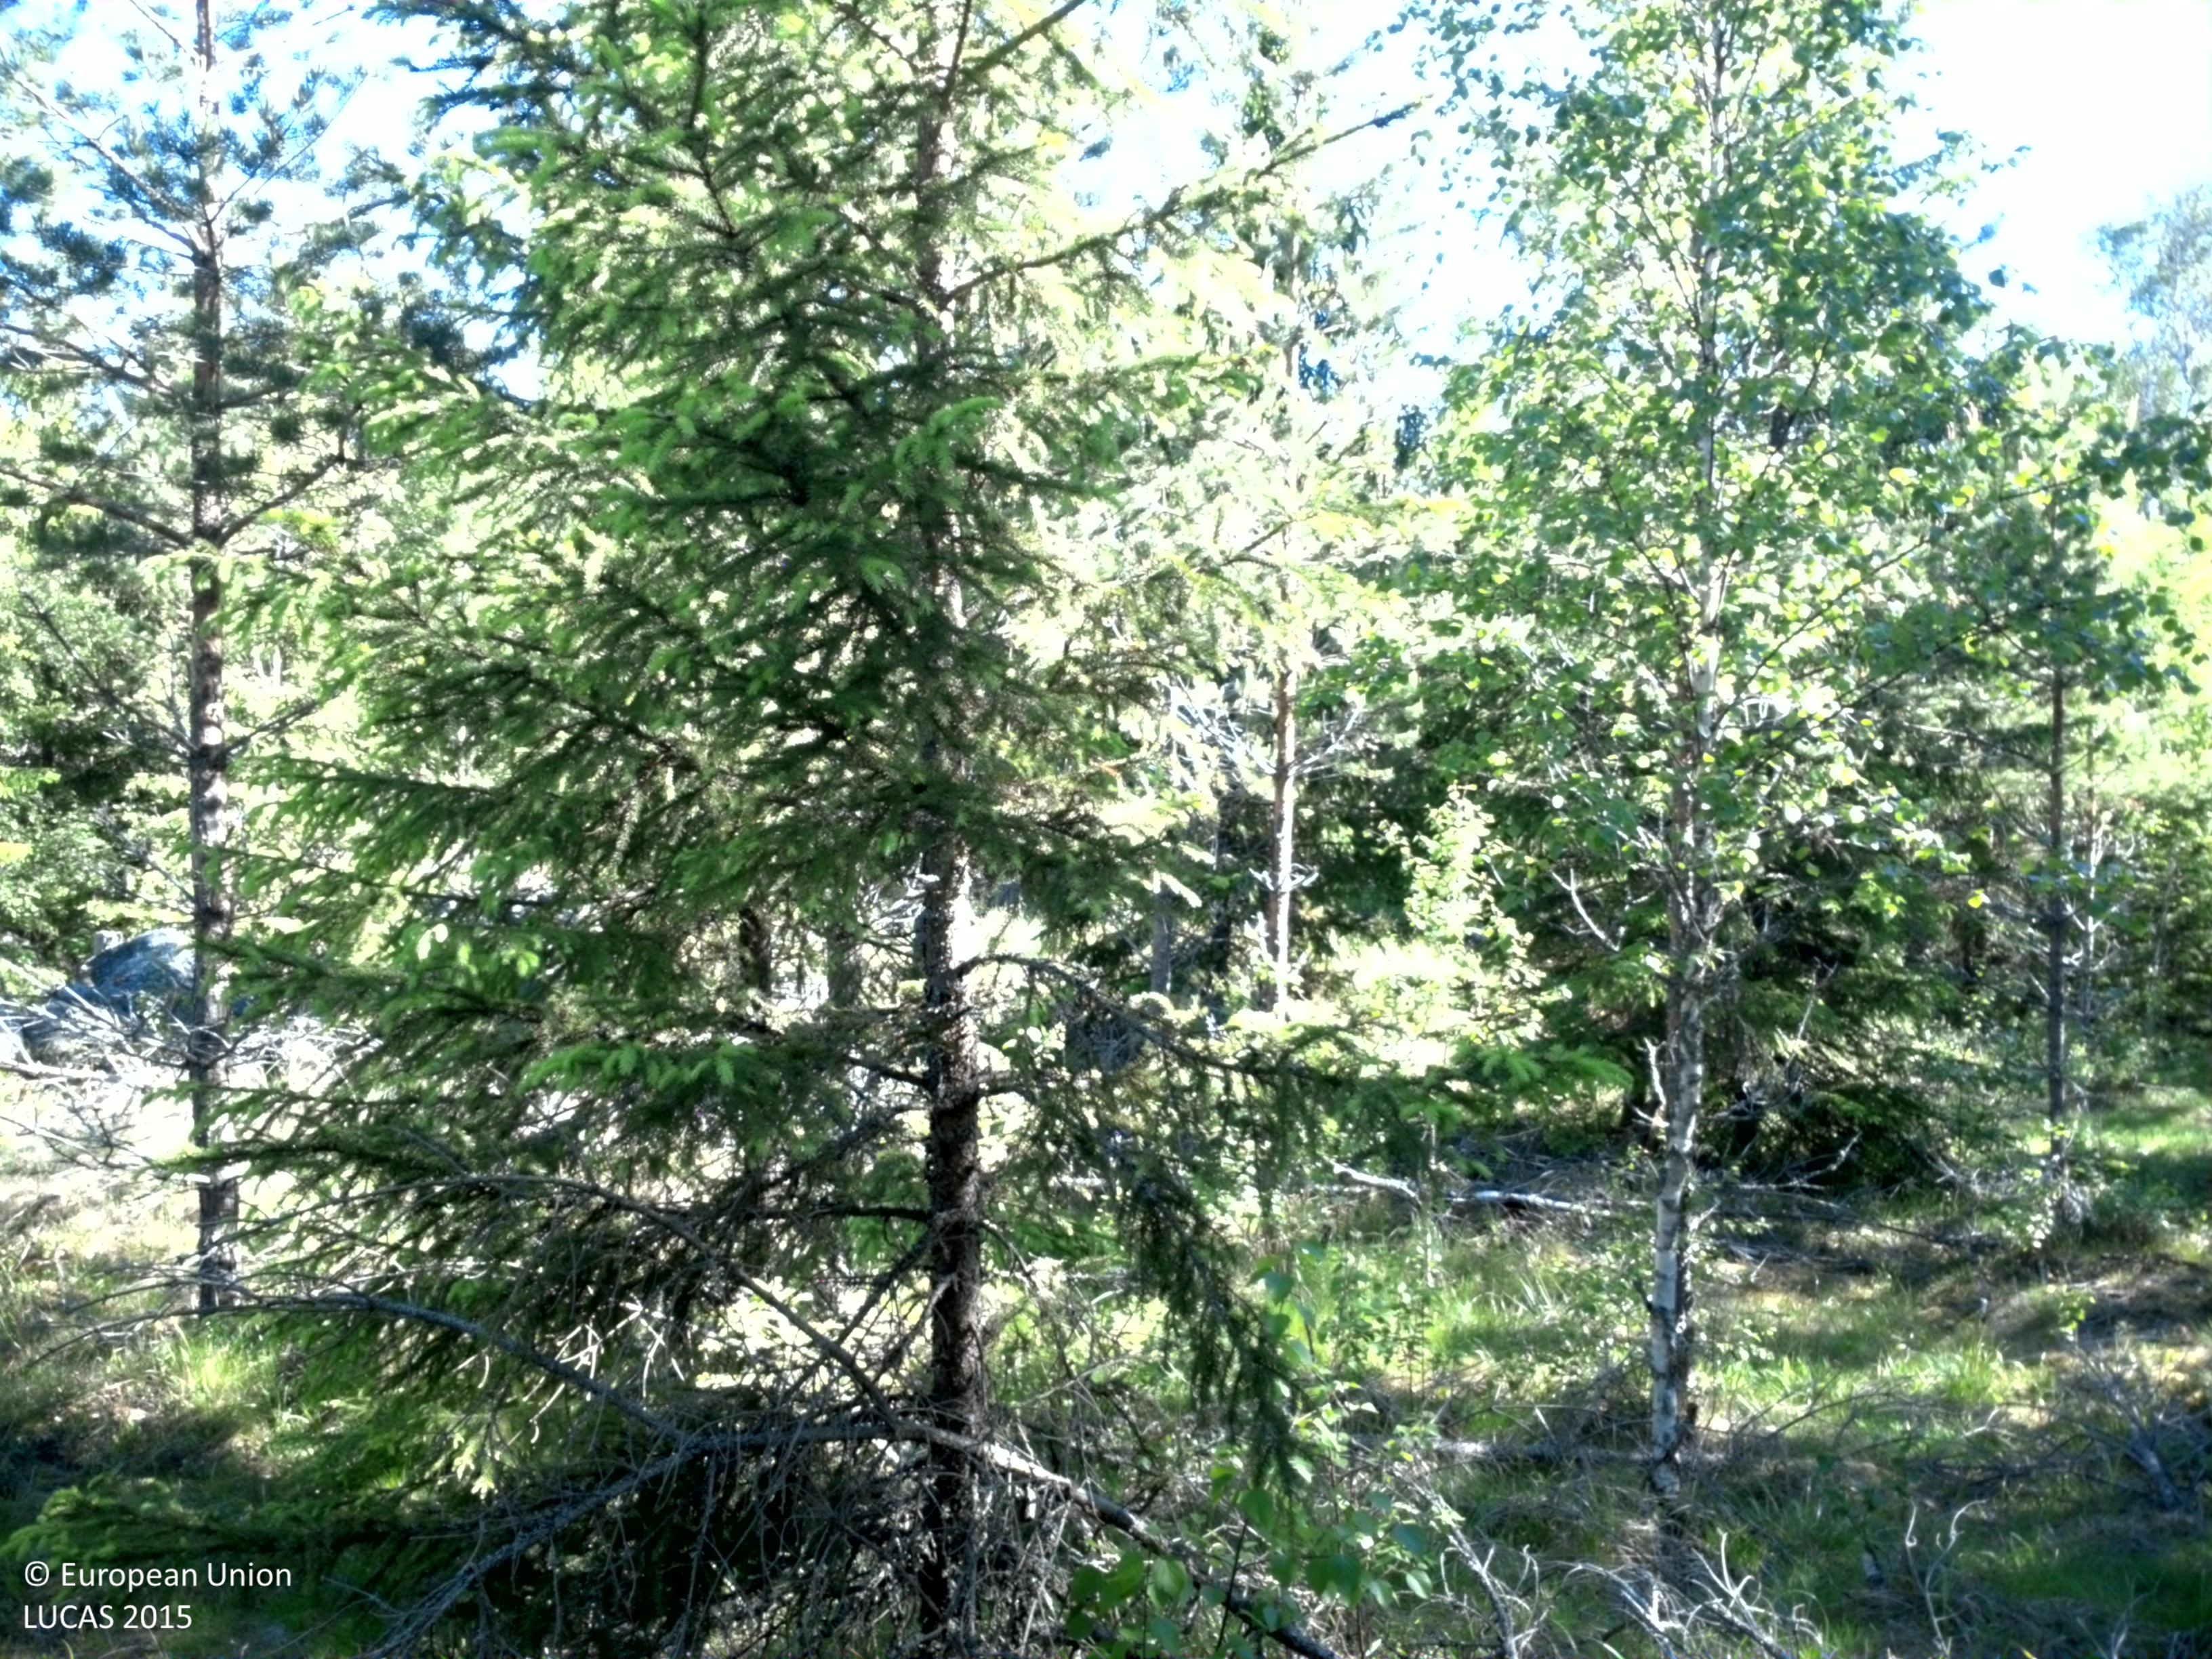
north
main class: Woodland
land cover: Other coniferous woodland
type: boreal forest
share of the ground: 50 - 75 %
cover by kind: coniferous forest trees 40 %, herbaceous plants 25 %, lichens and mosses 25 %, broadleaved forest trees 10 %
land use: Forestry
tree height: > 5 m
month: June
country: SE
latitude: 60.2142
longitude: 17.1920
